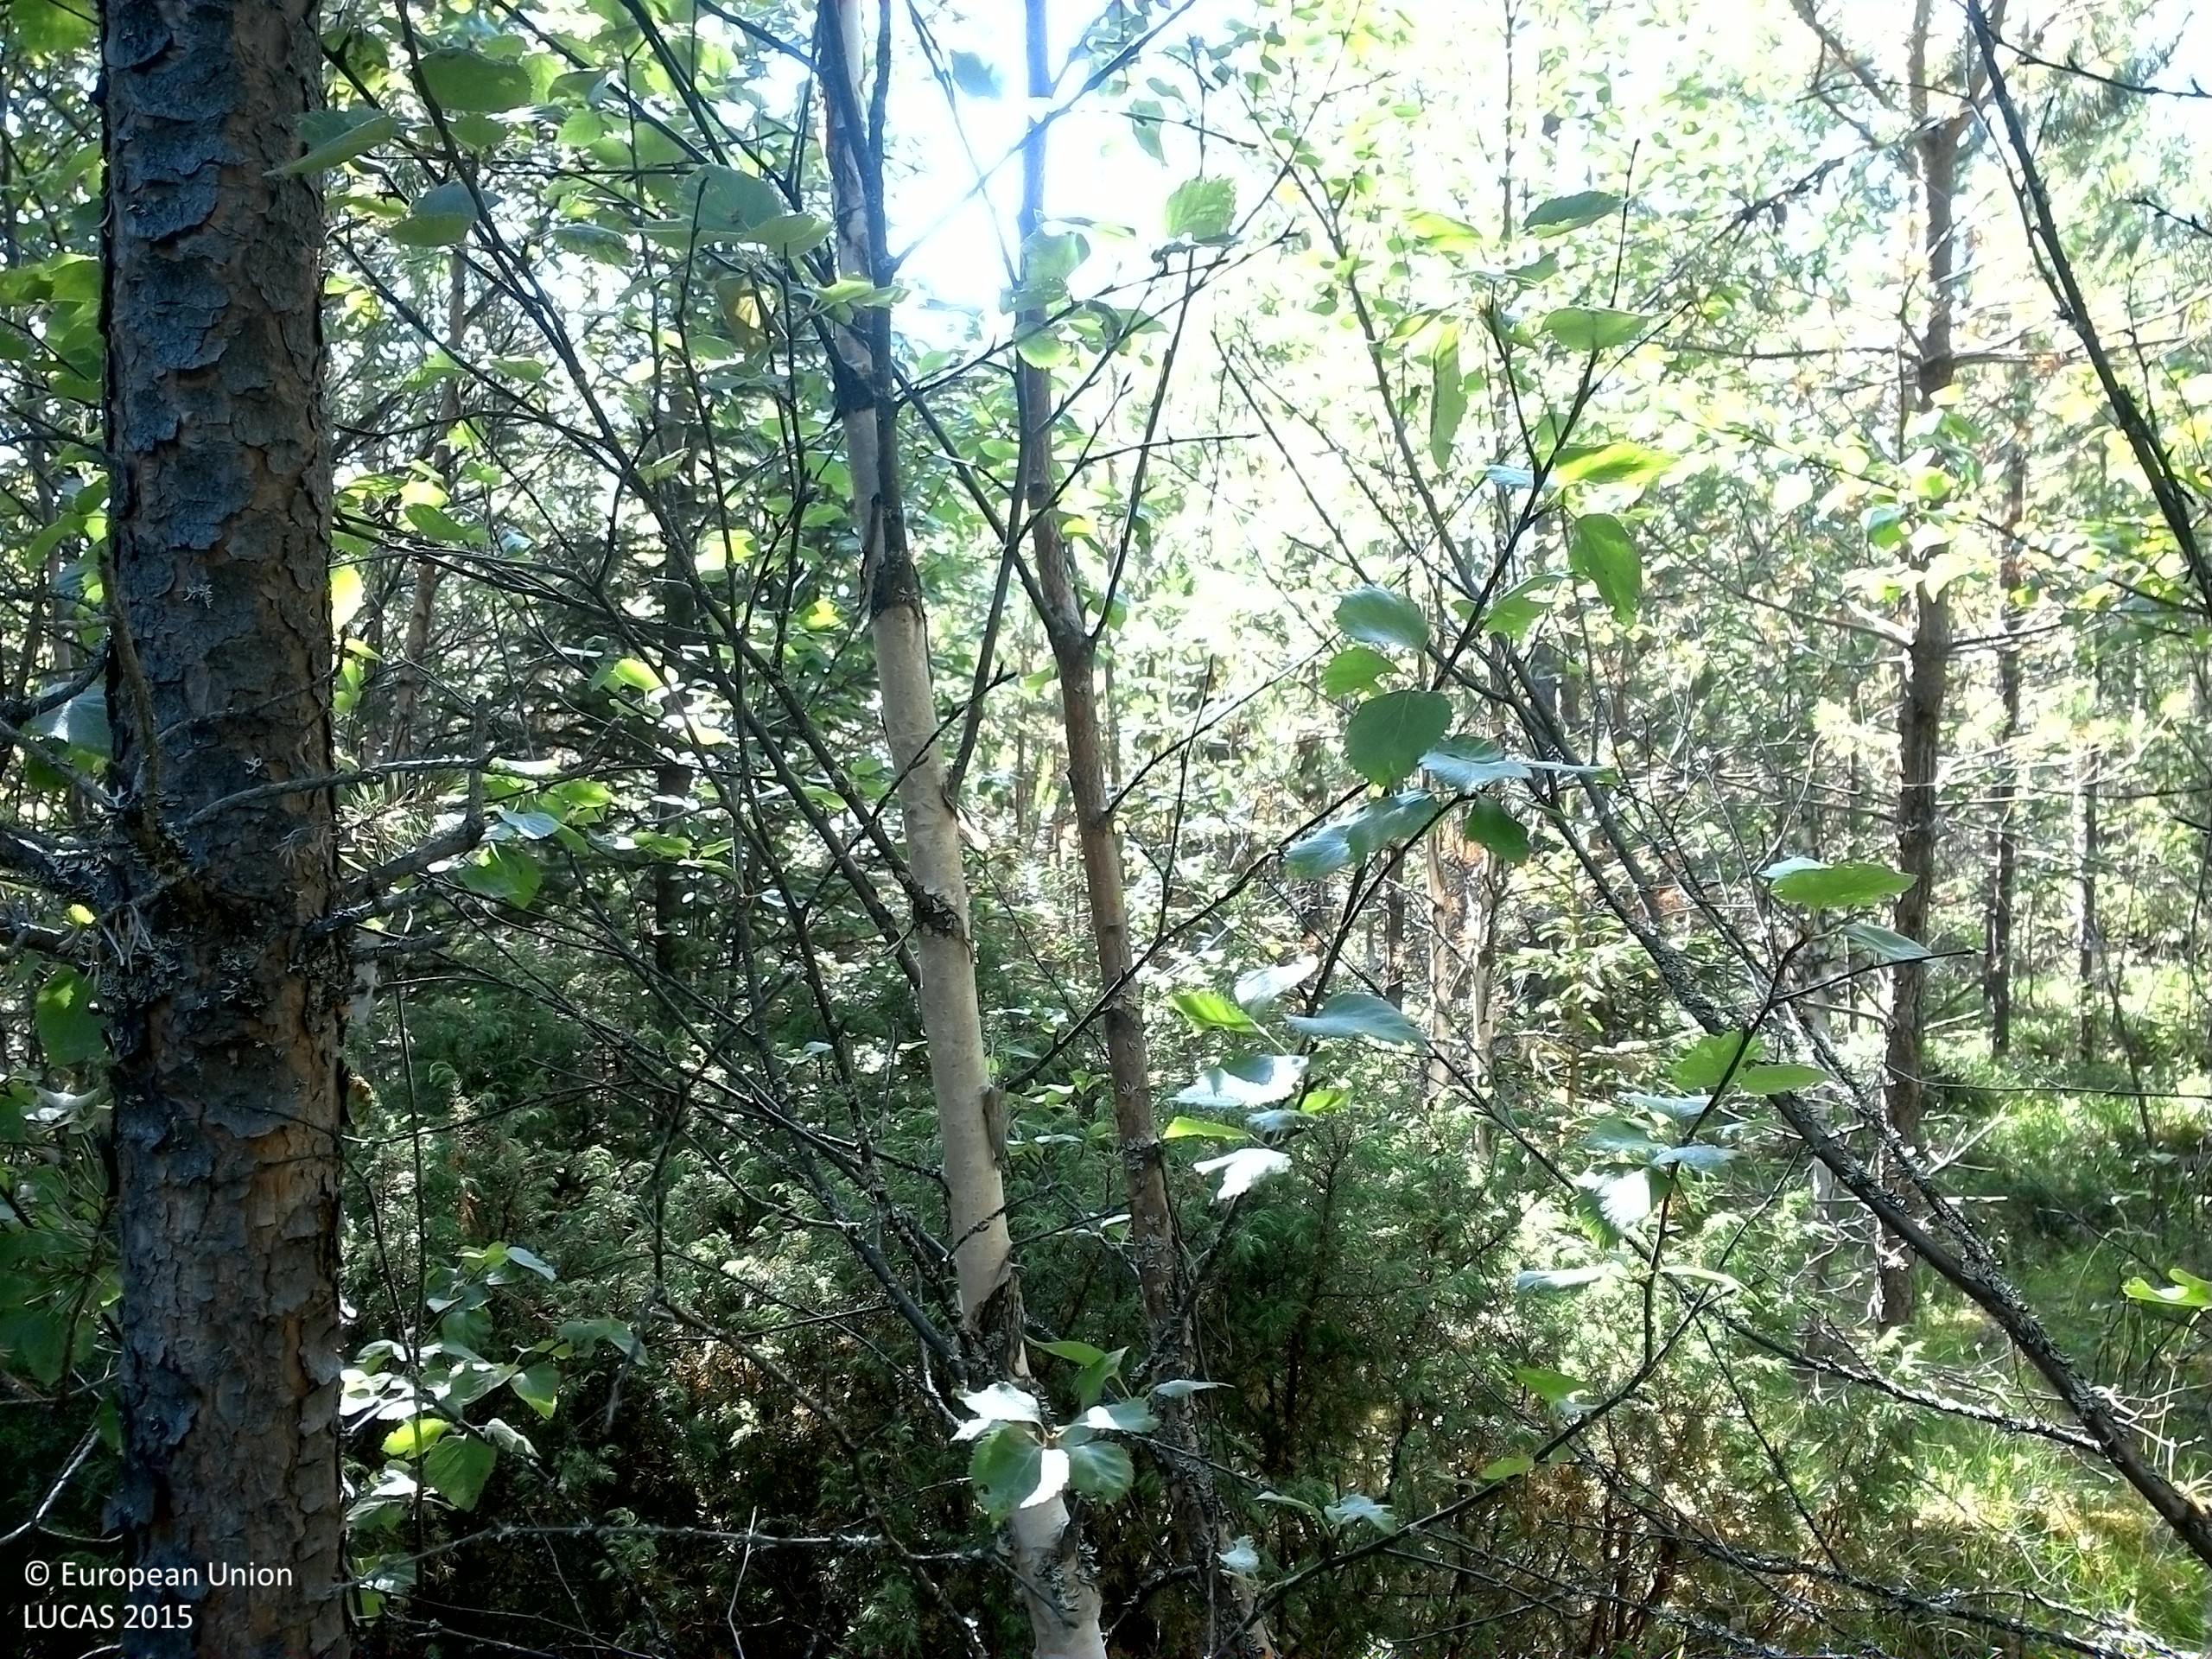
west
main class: Woodland
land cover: Pine dominated mixed woodland
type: boreal forest
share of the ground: > 75 %
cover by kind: coniferous forest trees 45 %, broadleaved forest trees 40 %, lichens and mosses 10 %, herbaceous plants 5 %
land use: Forestry
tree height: < 5 m
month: July
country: SE
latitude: 63.5586
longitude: 17.6832
